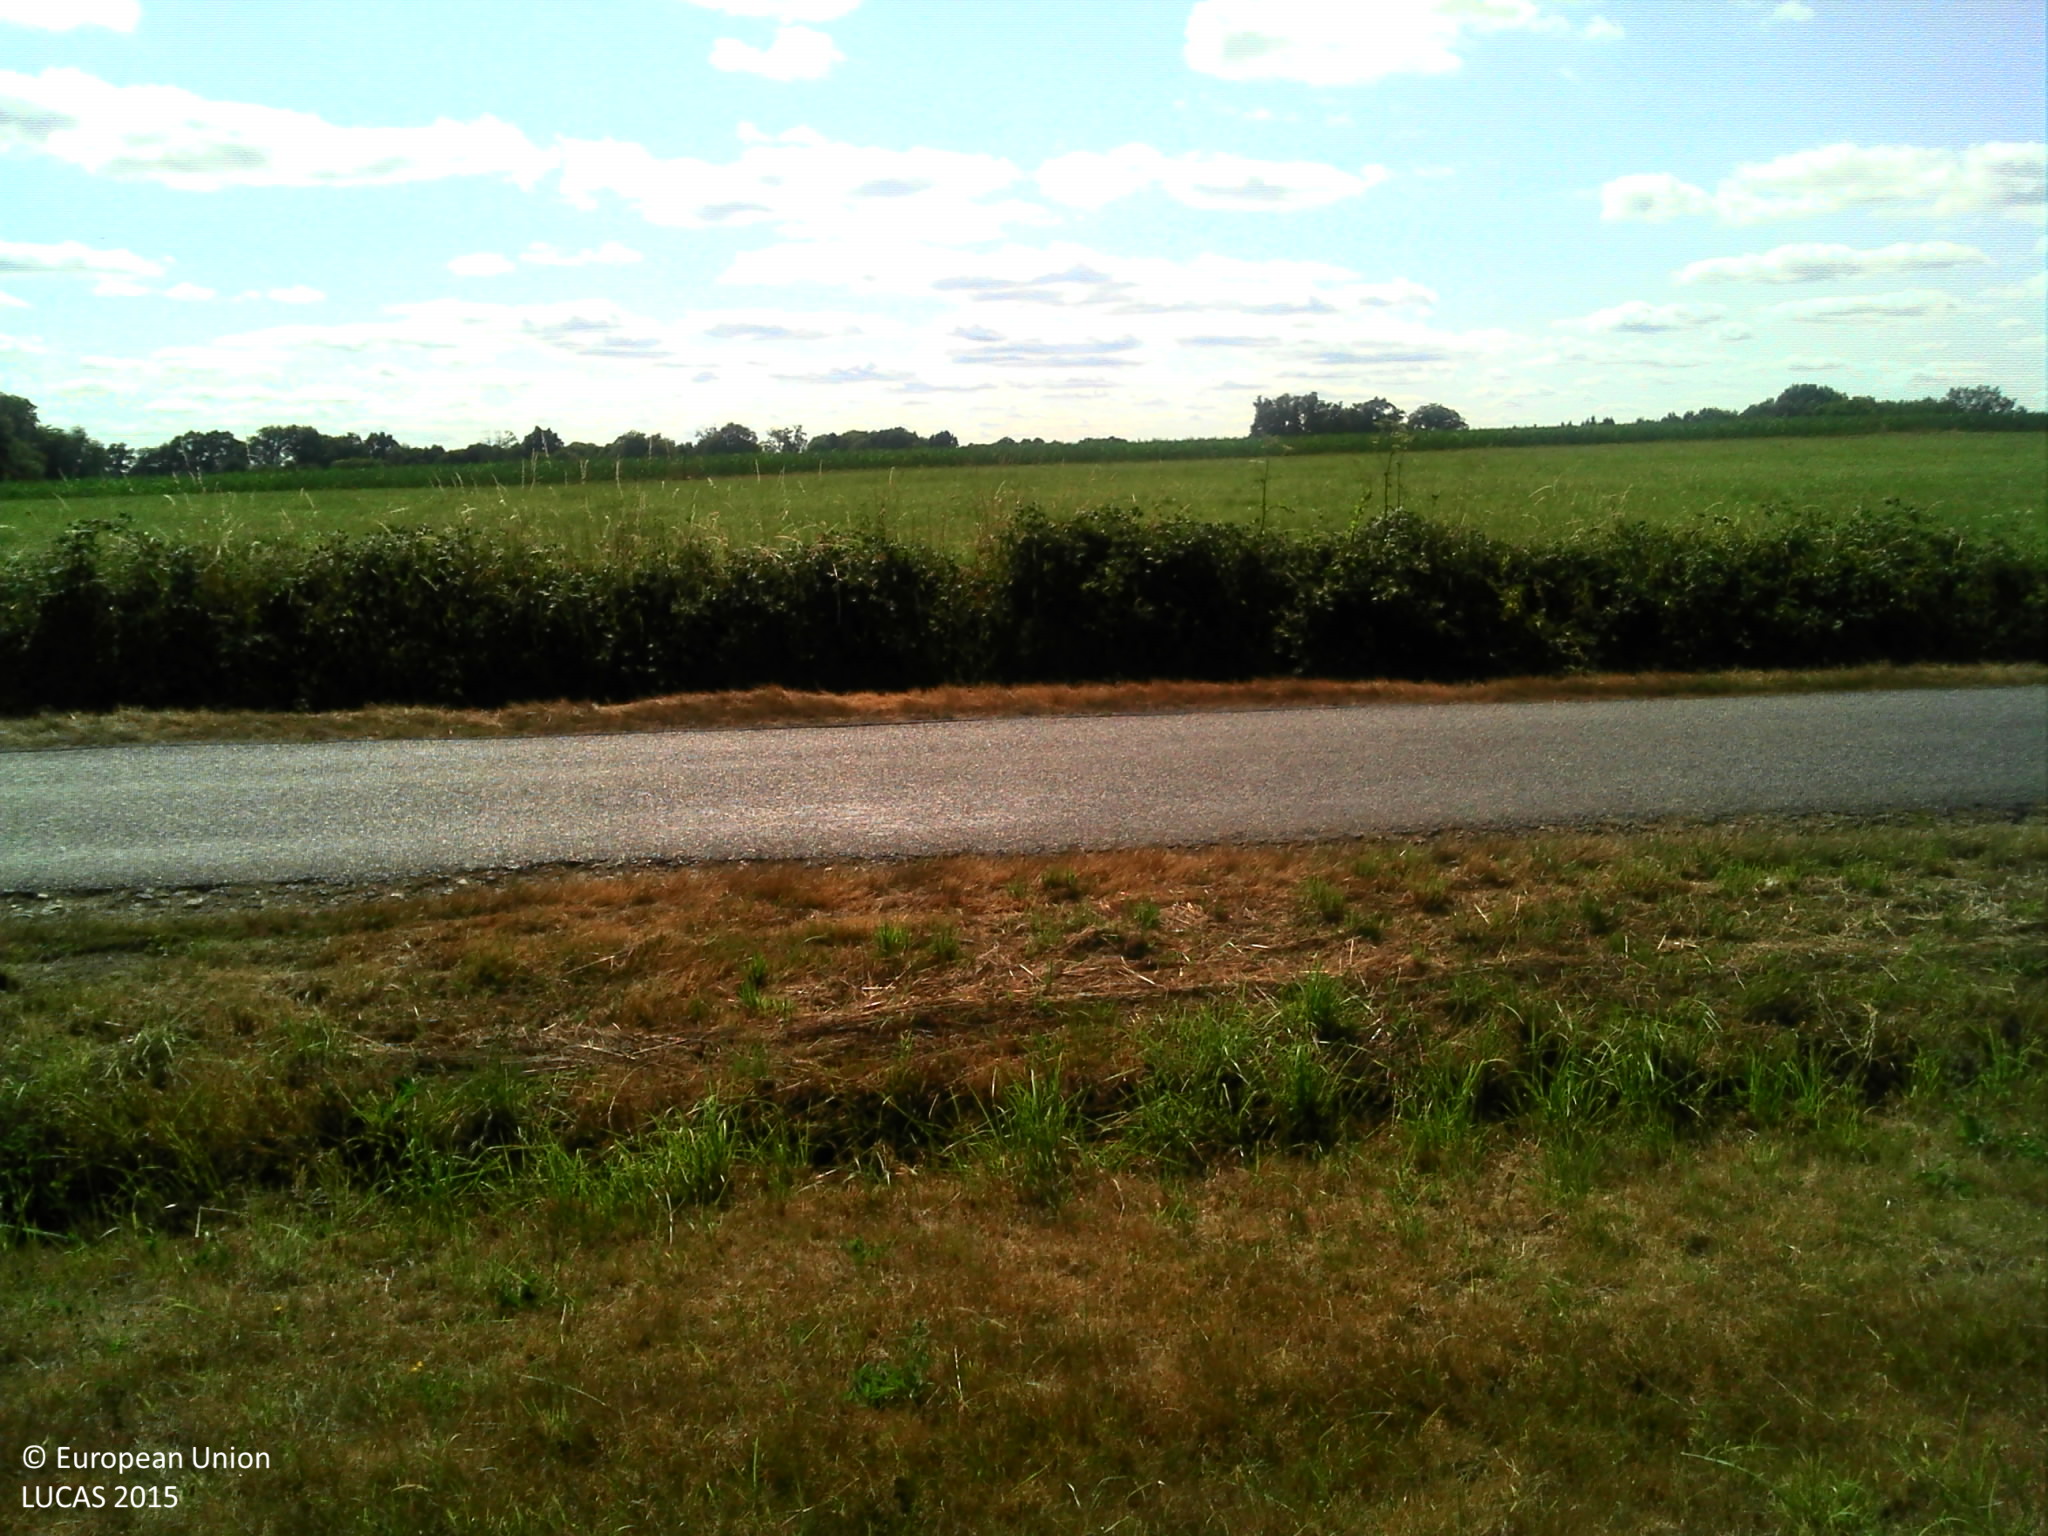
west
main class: Grassland
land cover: Grassland without tree/shrub cover
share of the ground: > 75 %
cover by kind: herbaceous plants 100 %
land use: Agriculture (excluding fallow land and kitchen gardens)
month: July
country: FR
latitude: 46.3113
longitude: 1.6155
